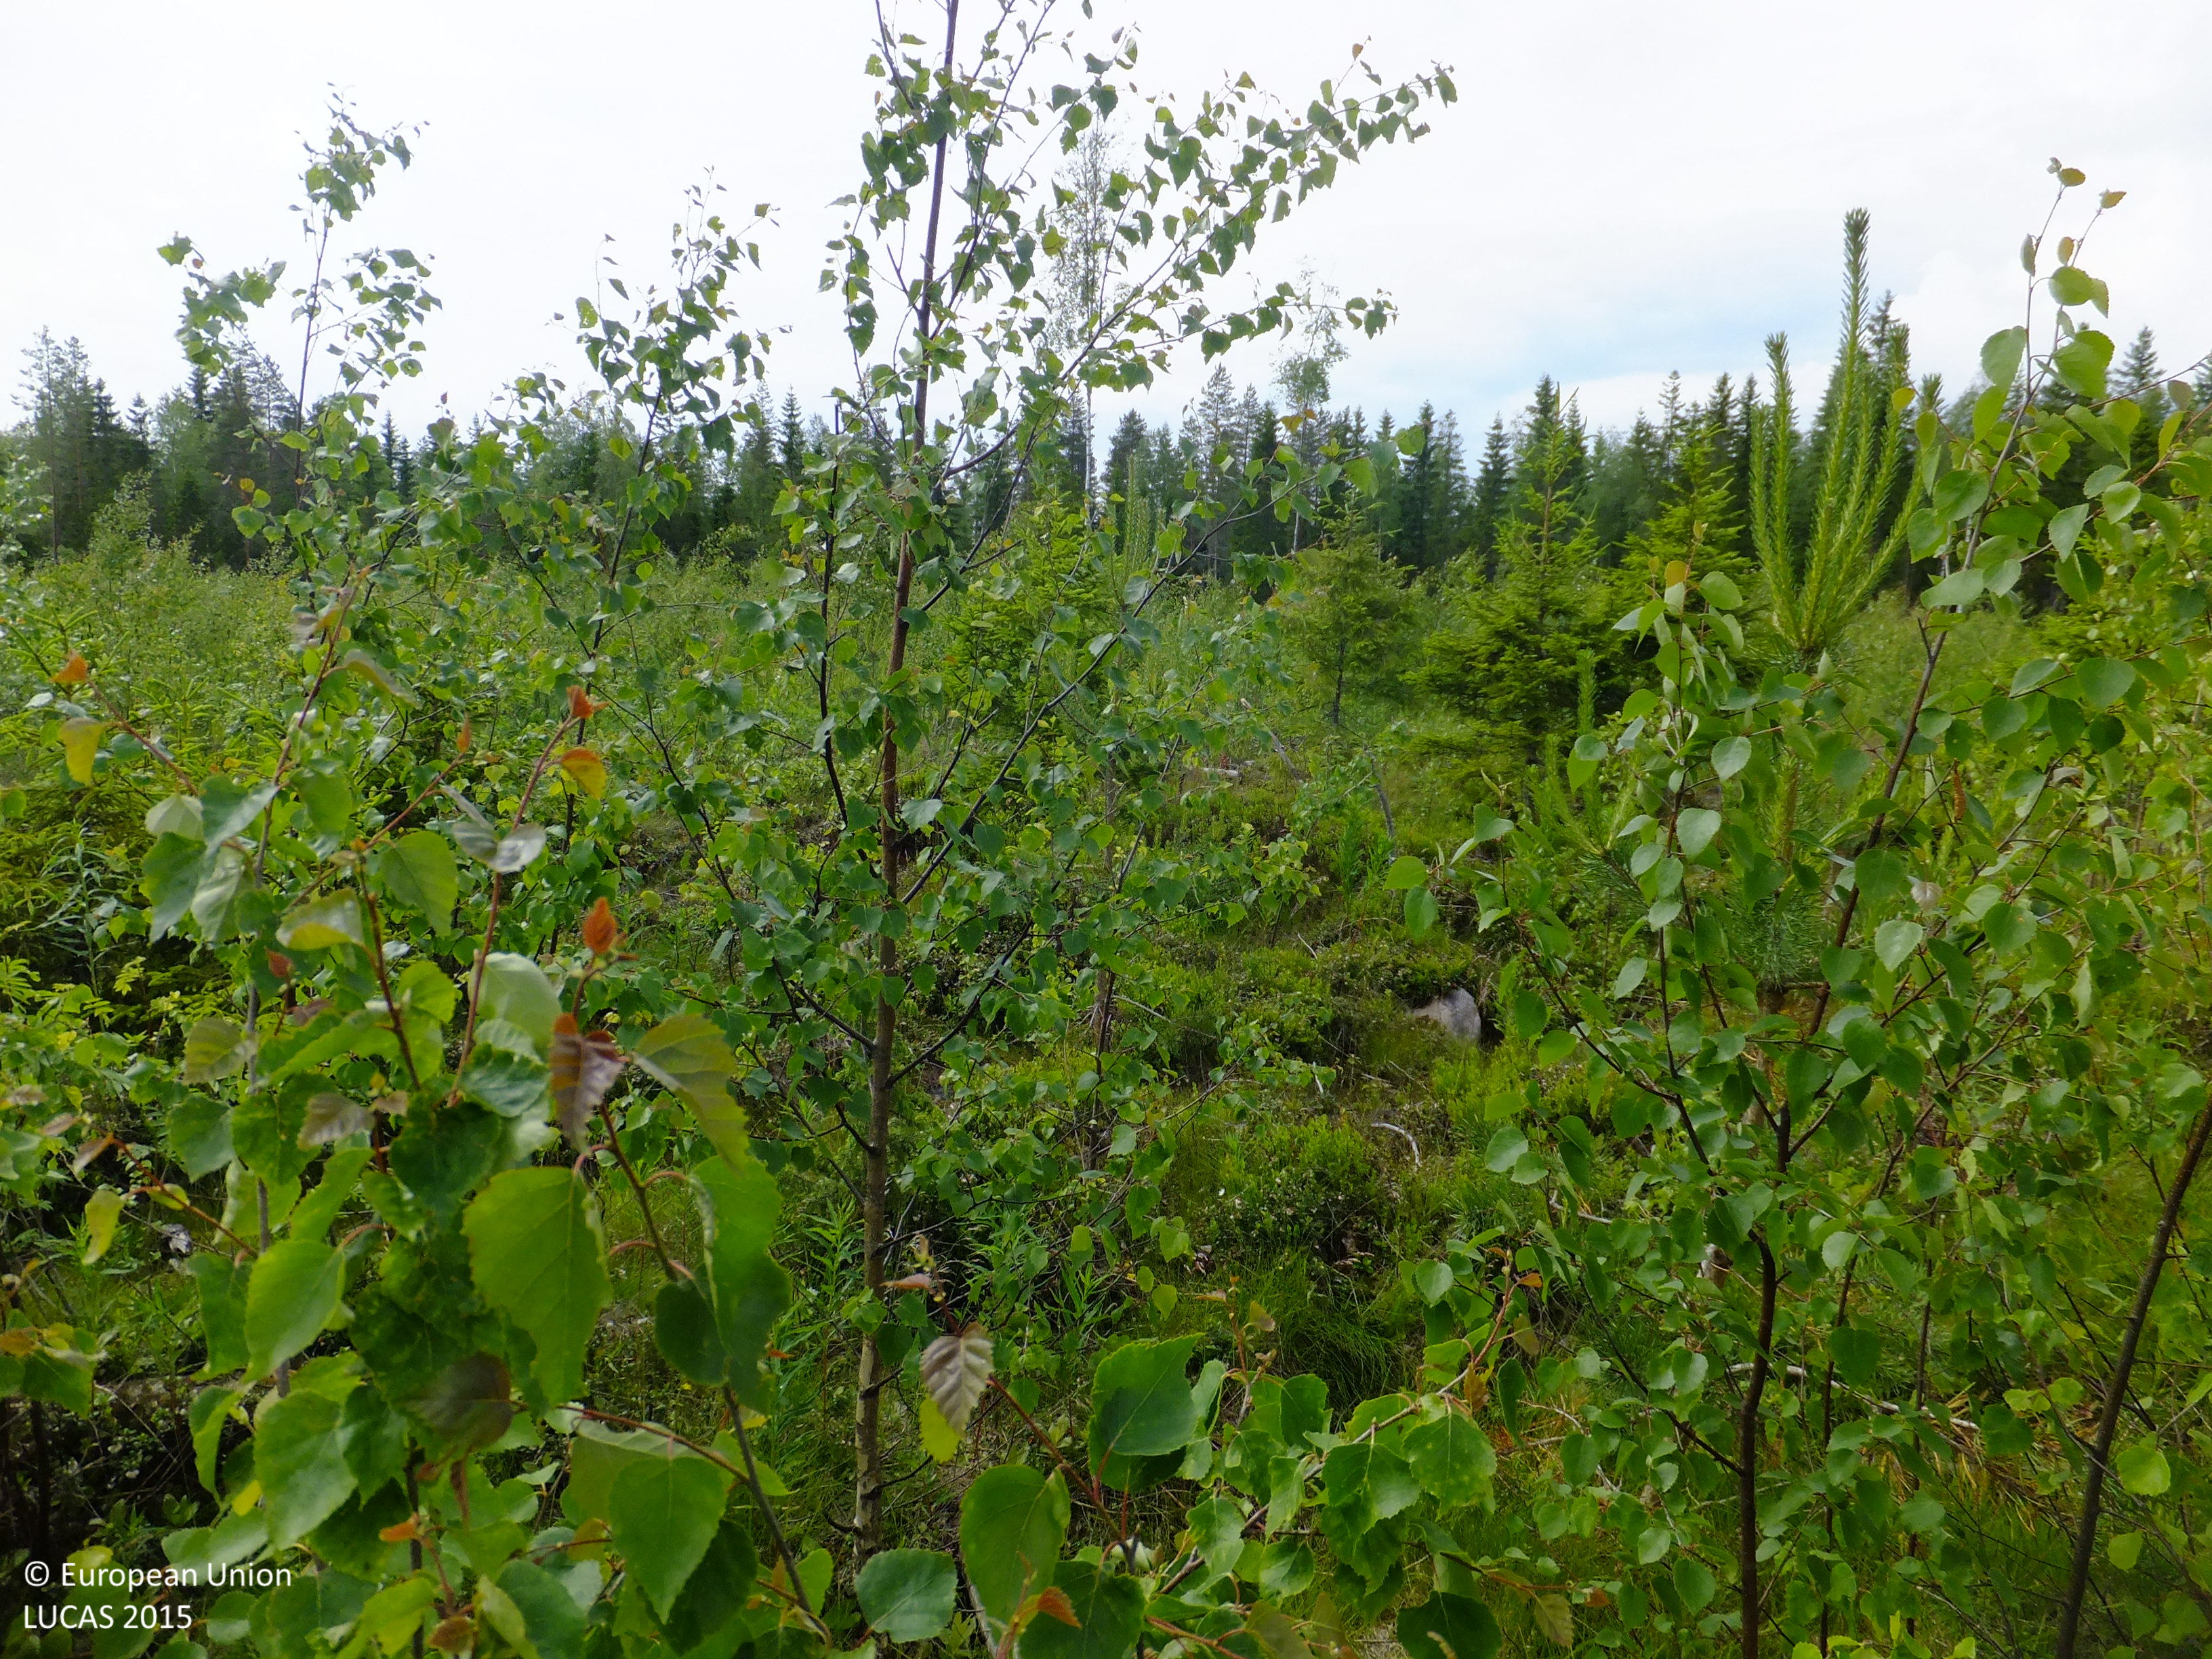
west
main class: Woodland
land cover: Pine dominated mixed woodland
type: boreal forest
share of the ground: 50 - 75 %
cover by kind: coniferous forest trees 30 %, broadleaved forest trees 30 %, herbaceous plants 20 %, shrubs 10 %, lichens and mosses 10 %
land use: Forestry
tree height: < 5 m
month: June
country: FI
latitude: 63.2448
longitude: 23.9497
